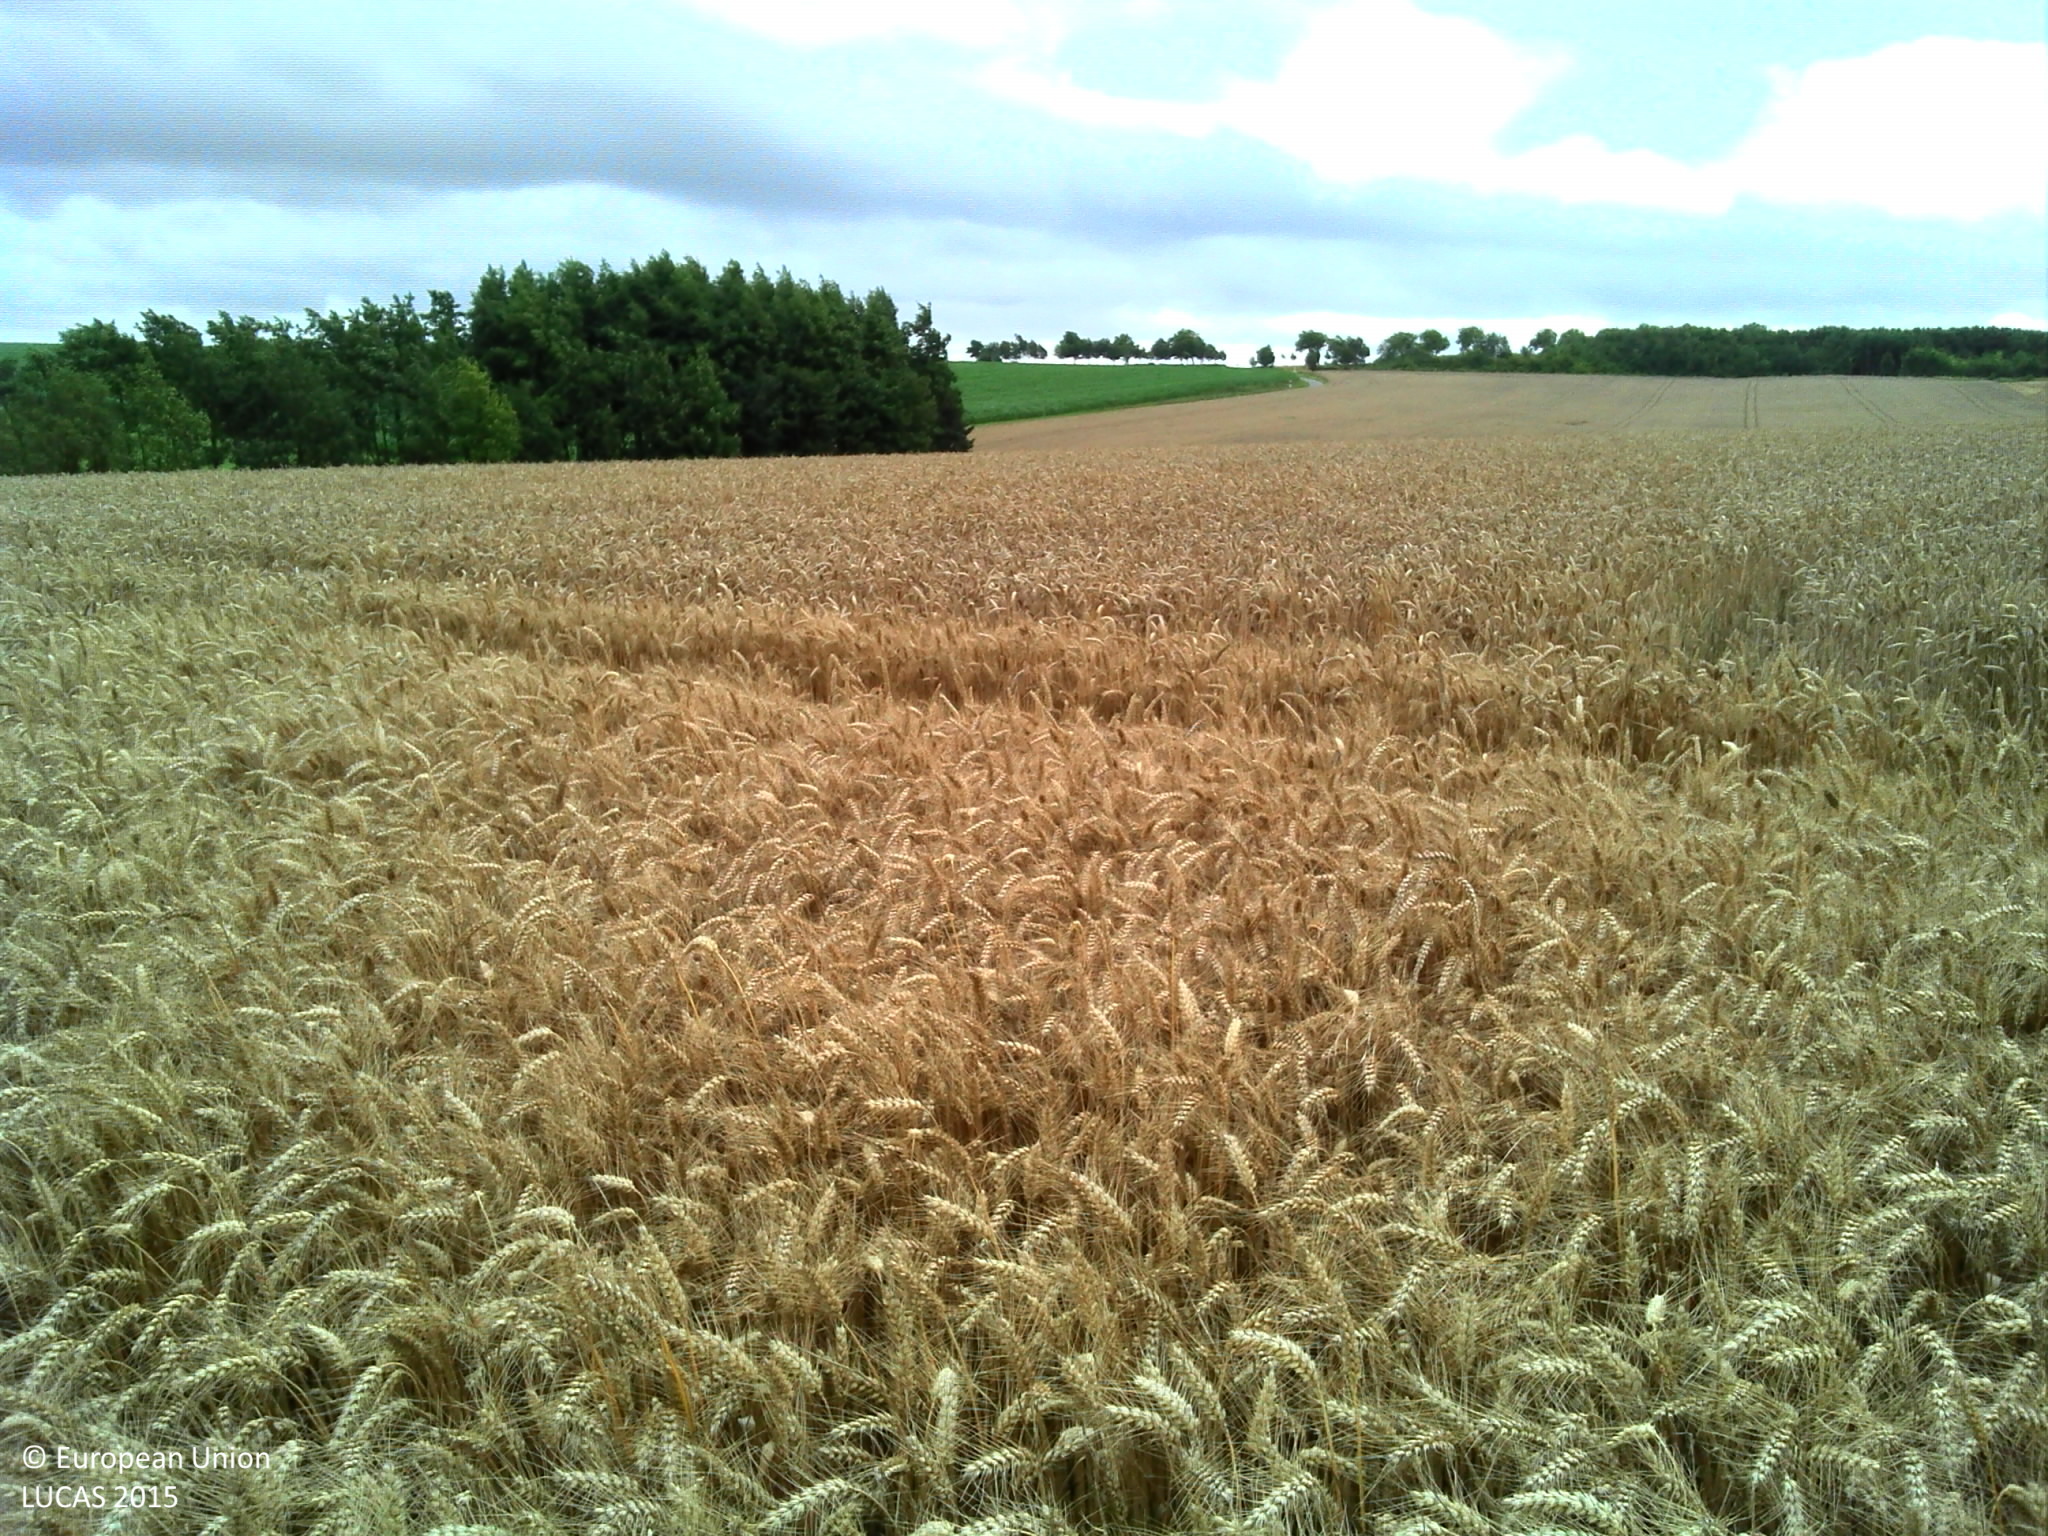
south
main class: Cropland
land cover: Common wheat
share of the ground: > 75 %
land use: Agriculture (excluding fallow land and kitchen gardens)
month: July
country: FR
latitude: 50.6512
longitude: 2.1069
